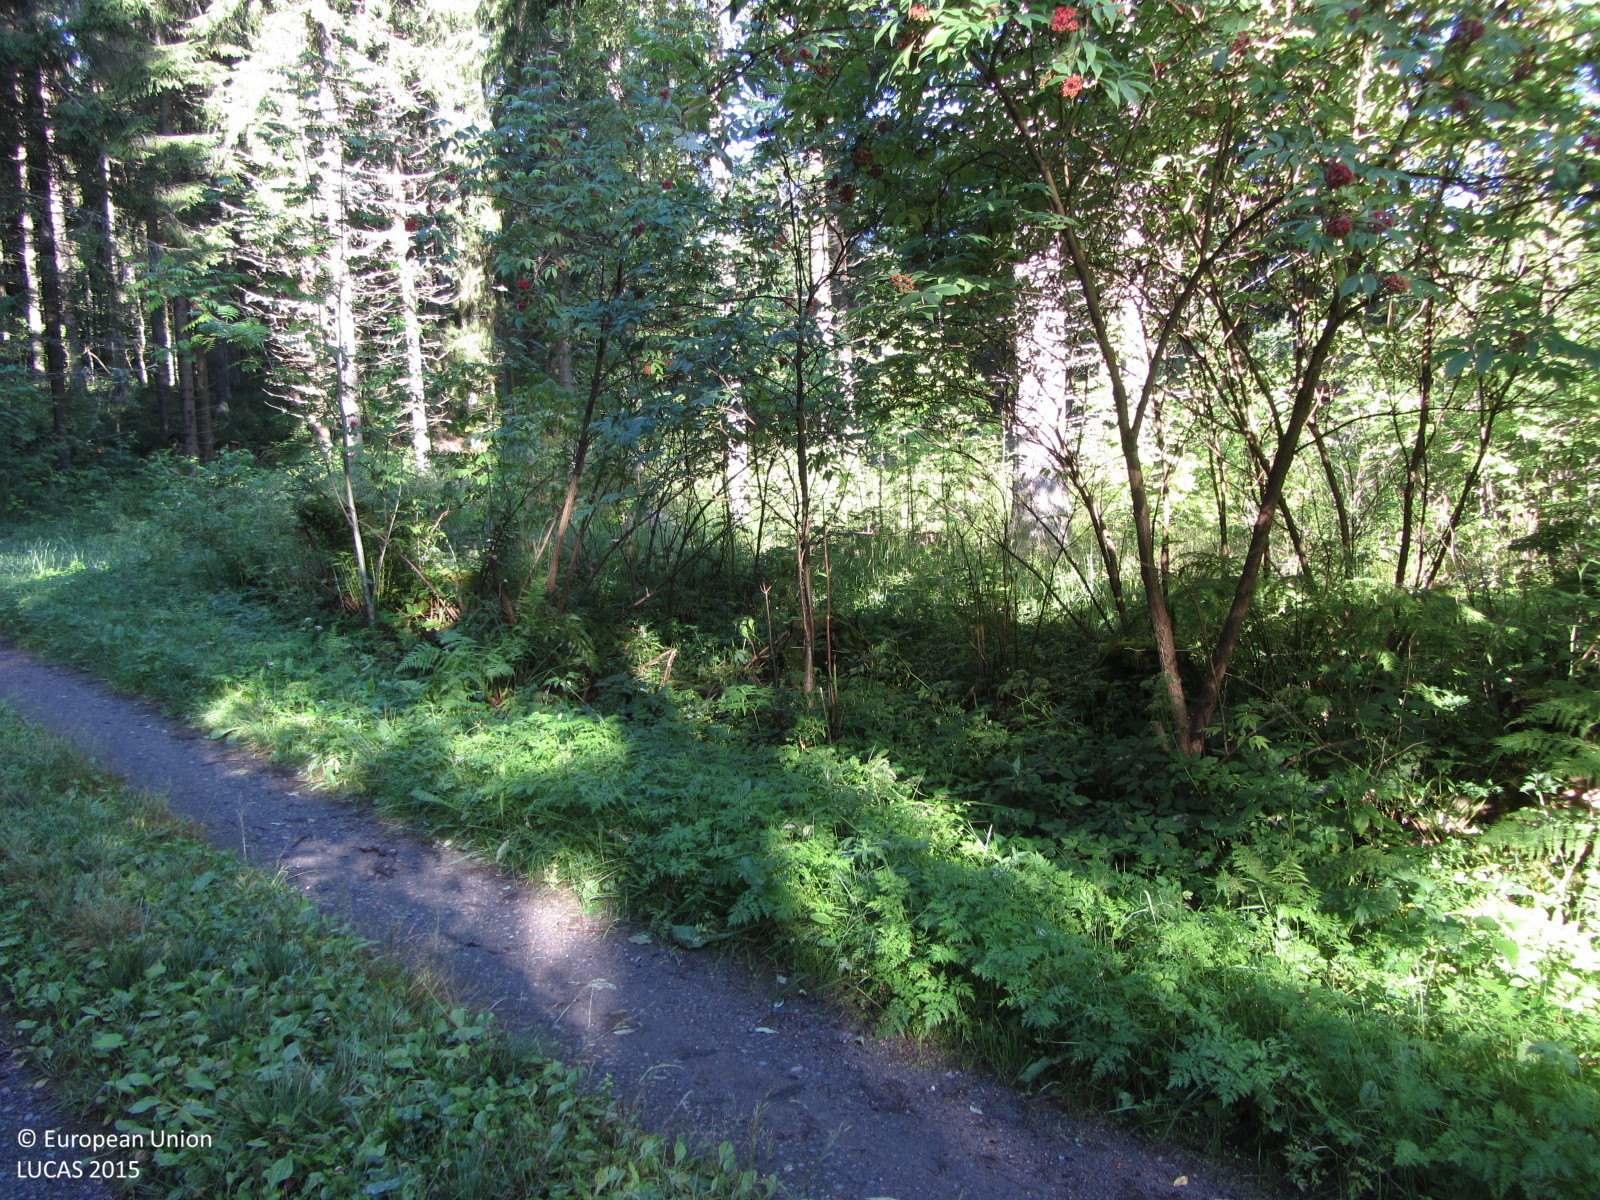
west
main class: Woodland
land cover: Spruce dominated coniferous woodland
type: boreal forest
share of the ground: 50 - 75 %
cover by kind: coniferous forest trees 70 %, herbaceous plants 20 %, broadleaved forest trees 10 %
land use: Forestry
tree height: > 5 m
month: July
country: FI
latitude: 60.6977
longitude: 24.4460
